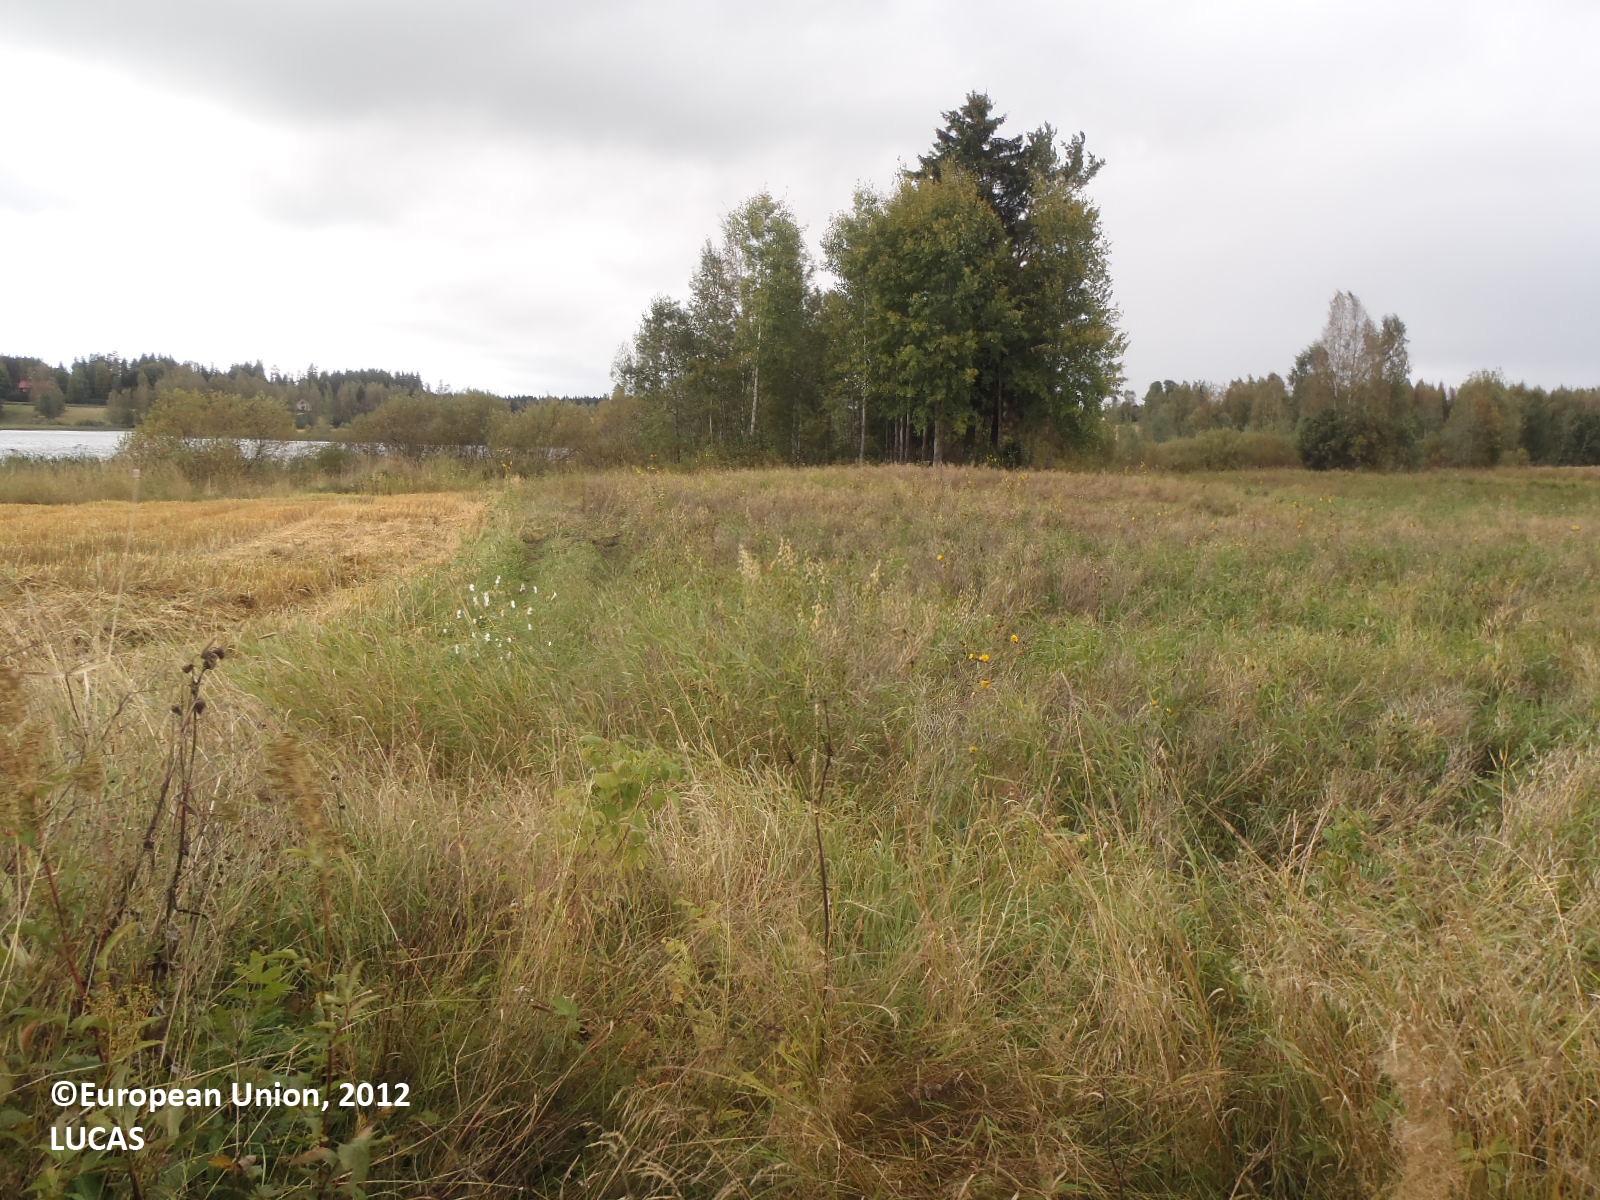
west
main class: Woodland
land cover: Broadleaved woodland
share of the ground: 50 - 75 %
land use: Forestry
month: September
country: FI
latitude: 61.6450
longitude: 22.7690
